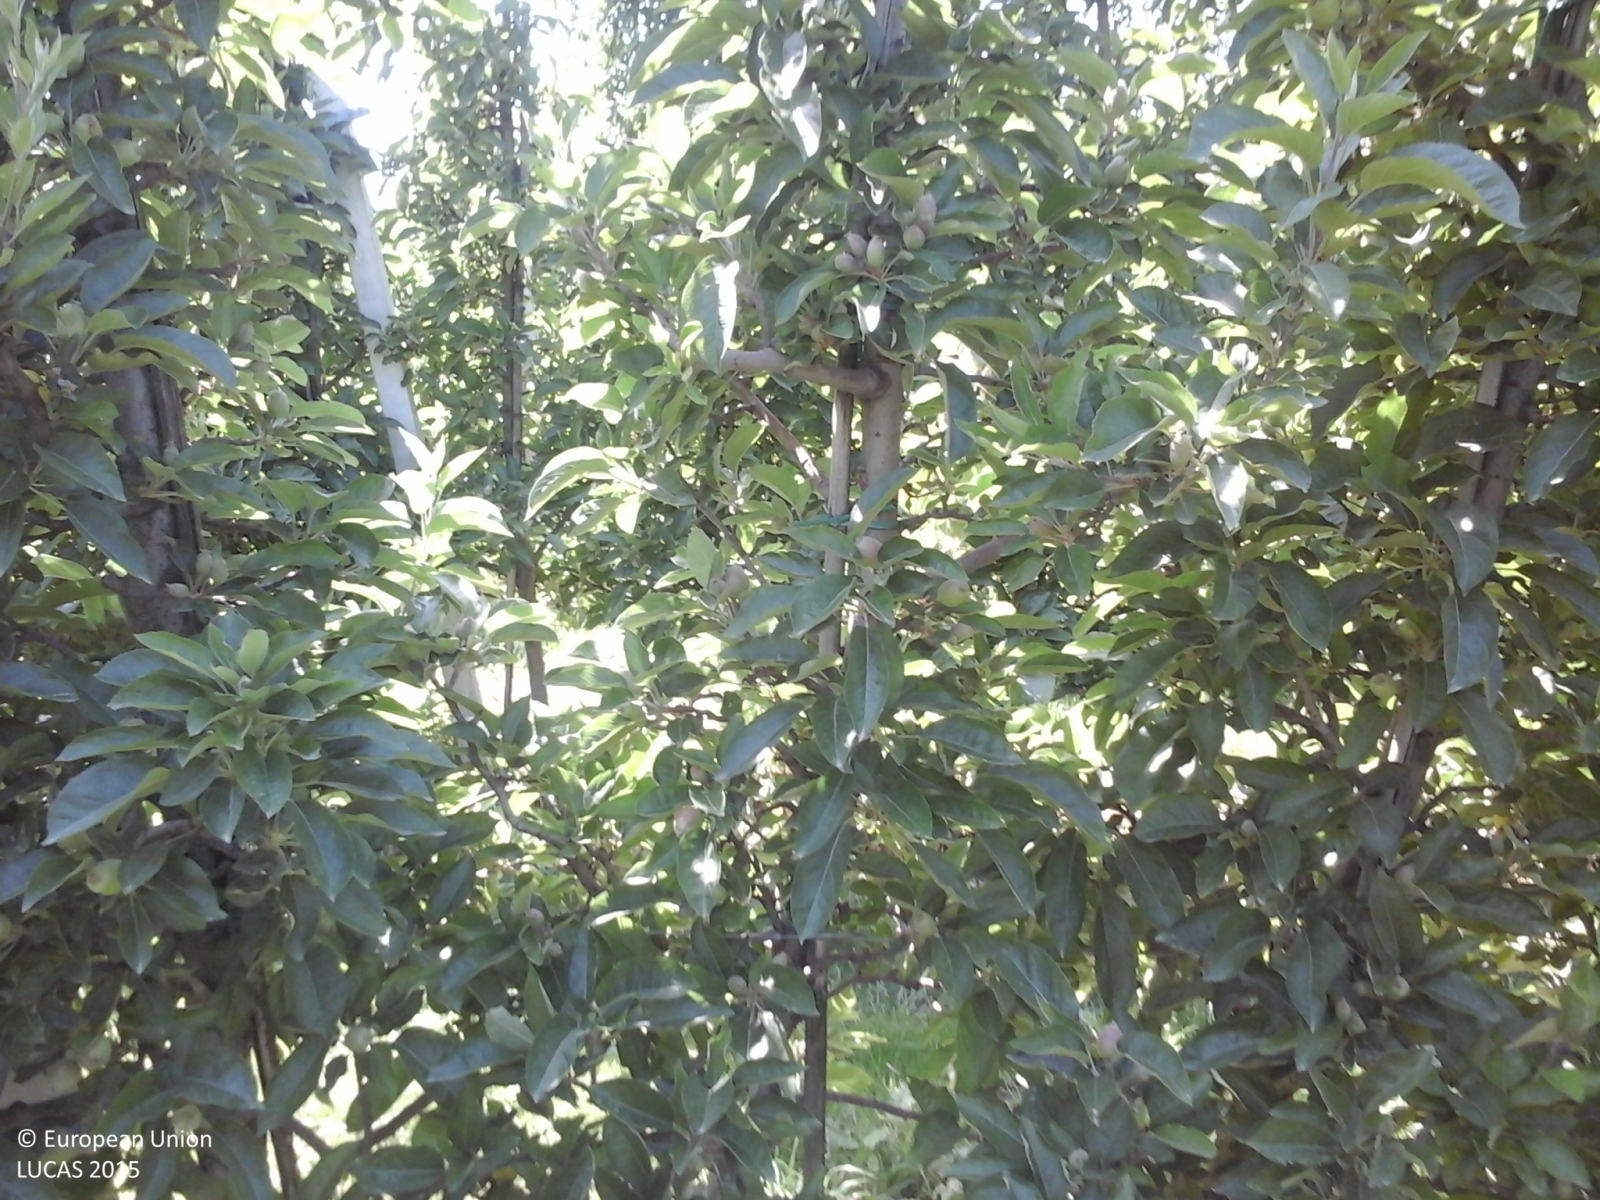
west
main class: Cropland
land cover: Apple fruit
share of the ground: > 75 %
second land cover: Grassland without tree/shrub cover
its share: > 75 %
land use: Agriculture (excluding fallow land and kitchen gardens)
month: May
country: IT
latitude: 46.6180
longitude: 10.8478
